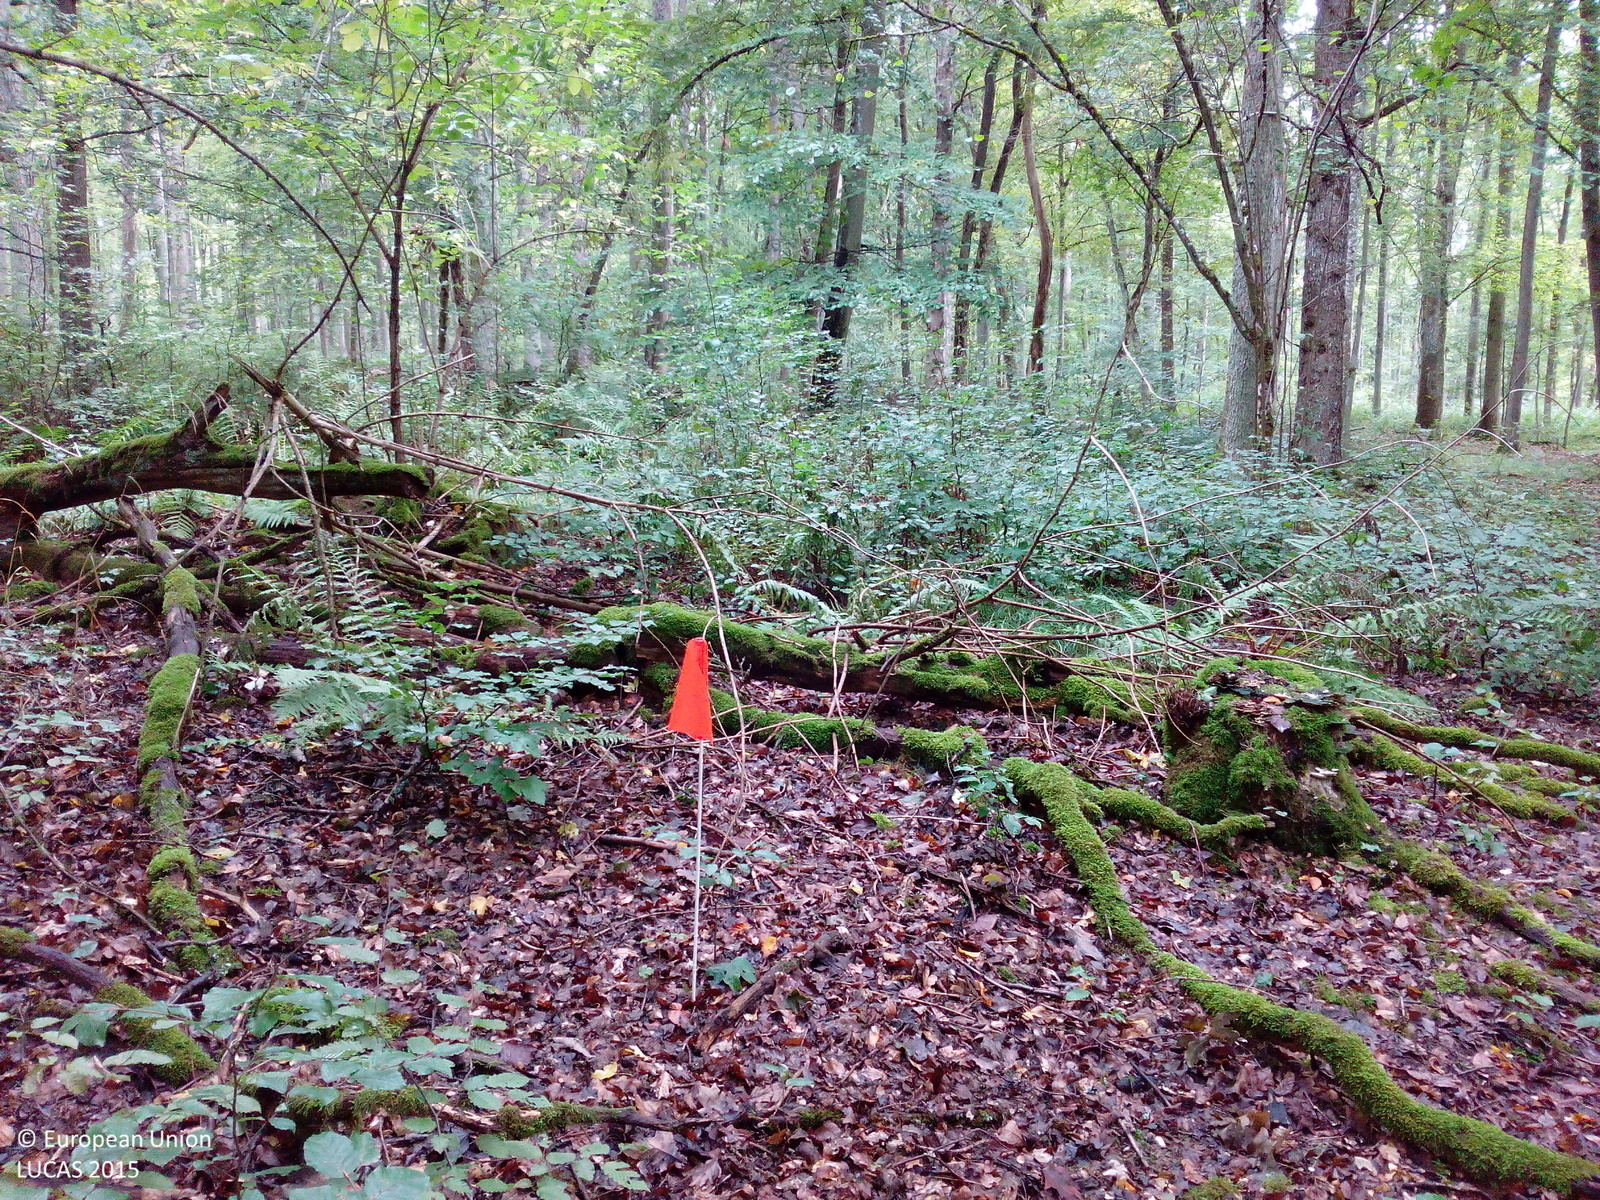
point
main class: Woodland
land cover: Broadleaved woodland
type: acidophilous oak and oak-birch forest
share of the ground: > 75 %
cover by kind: broadleaved forest trees 90 %, shrubs 5 %, unconsolidated bare surface 5 %
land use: Forestry
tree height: > 5 m
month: September
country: DE
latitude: 50.0044
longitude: 9.9024
